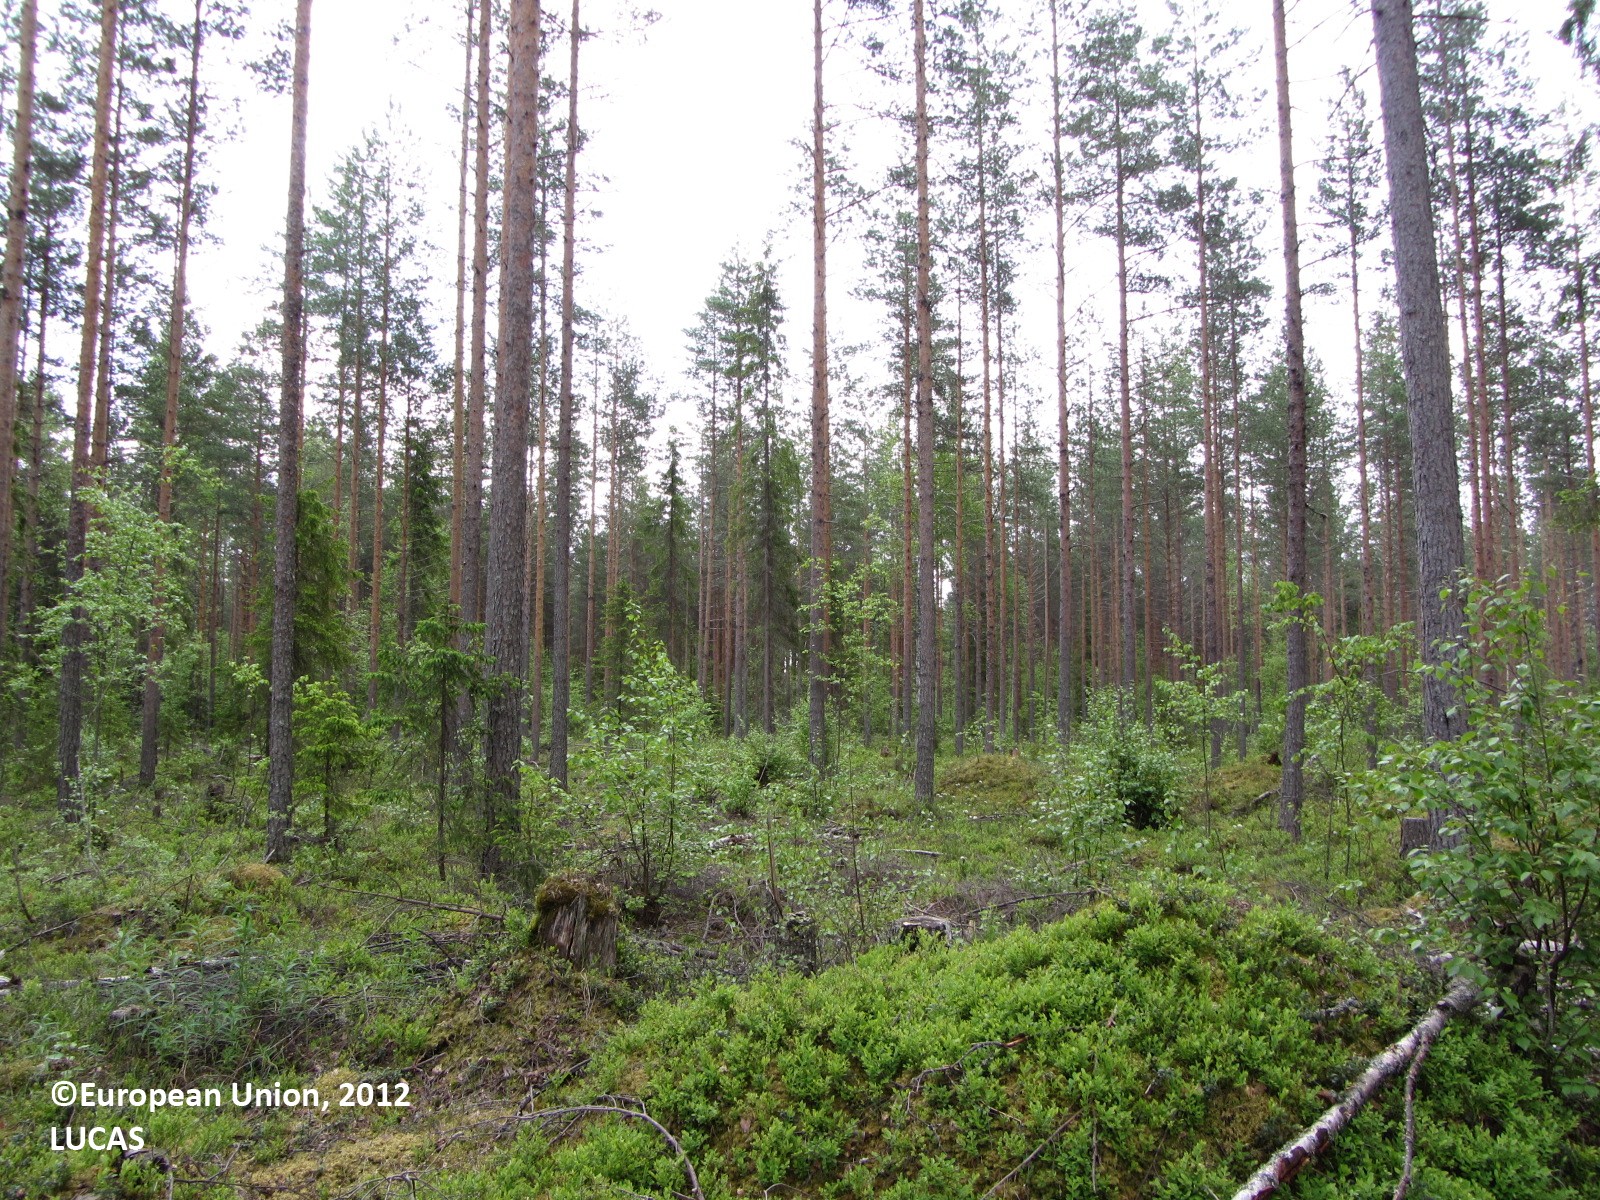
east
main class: Woodland
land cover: Pine dominated mixed woodland
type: boreal forest
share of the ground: 50 - 75 %
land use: Forestry
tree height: > 5 m
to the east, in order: Pine dominated mixed woodland; Tracks; Pine dominated mixed woodland; Ditches and canals; Pine dominated mixed woodland; Ditches and canals; Pine dominated mixed woodland; Tracks; Pine dominated mixed woodland; Shrubland with sparse tree cover; Pine dominated mixed woodland; Spruce dominated mixed woodland; Tracks; Other mixed woodland
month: June
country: FI
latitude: 61.9361
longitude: 25.1033
